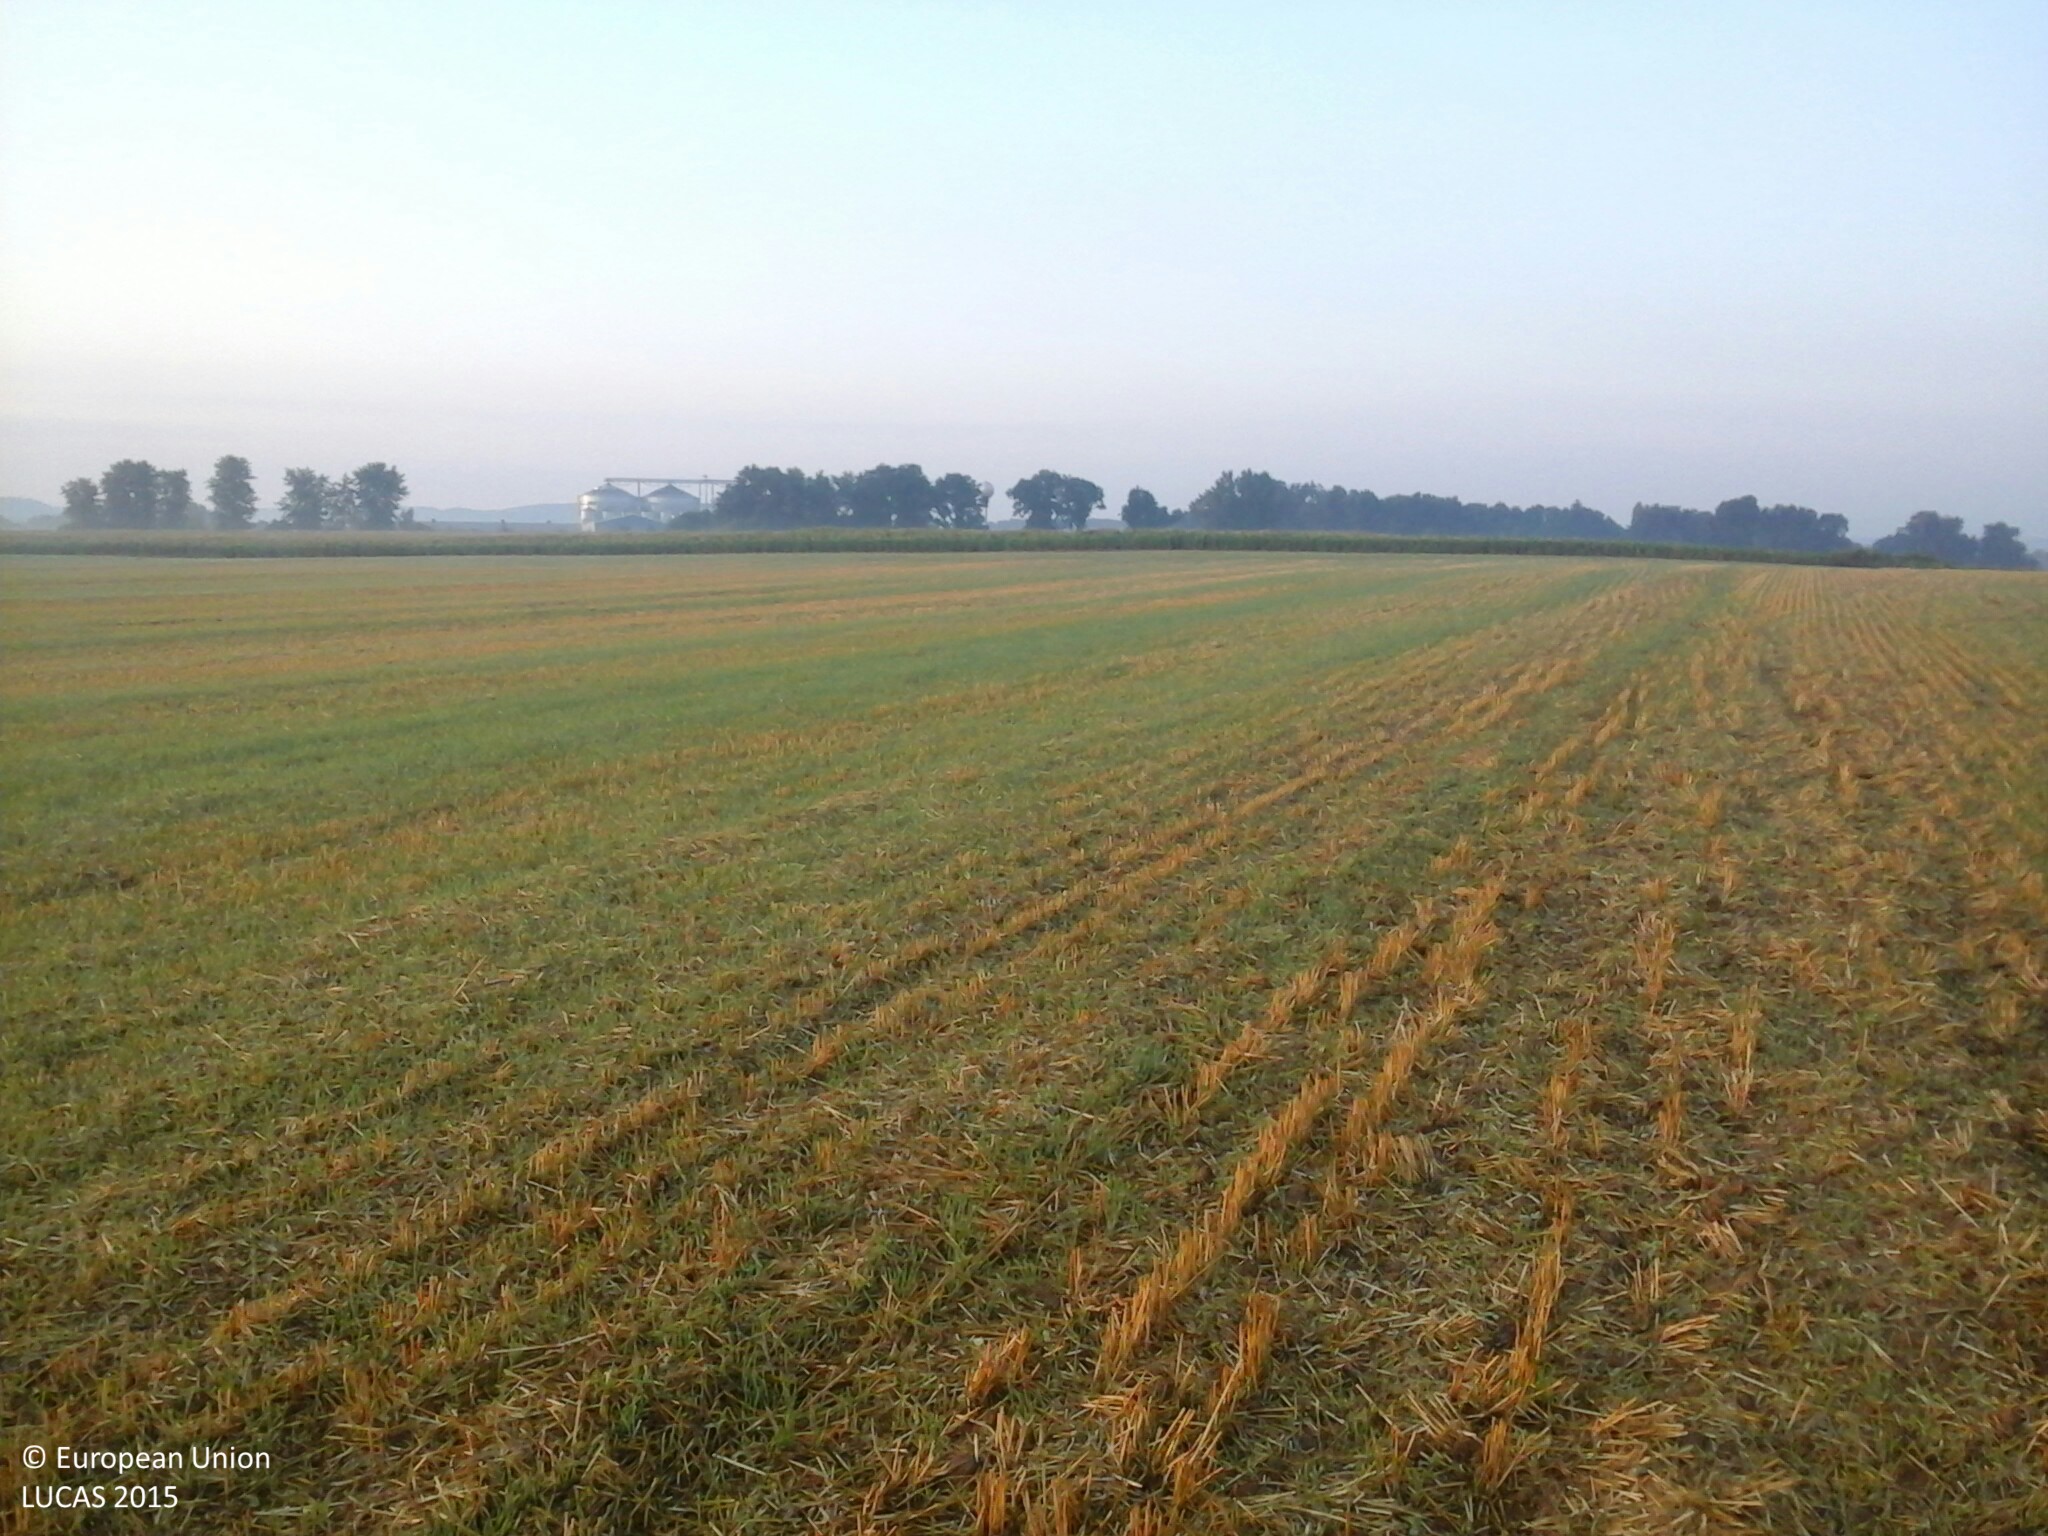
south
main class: Cropland
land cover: Common wheat
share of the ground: 50 - 75 %
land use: Agriculture (excluding fallow land and kitchen gardens)
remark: Harvested field
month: August
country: HU
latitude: 47.5272
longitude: 18.3407
